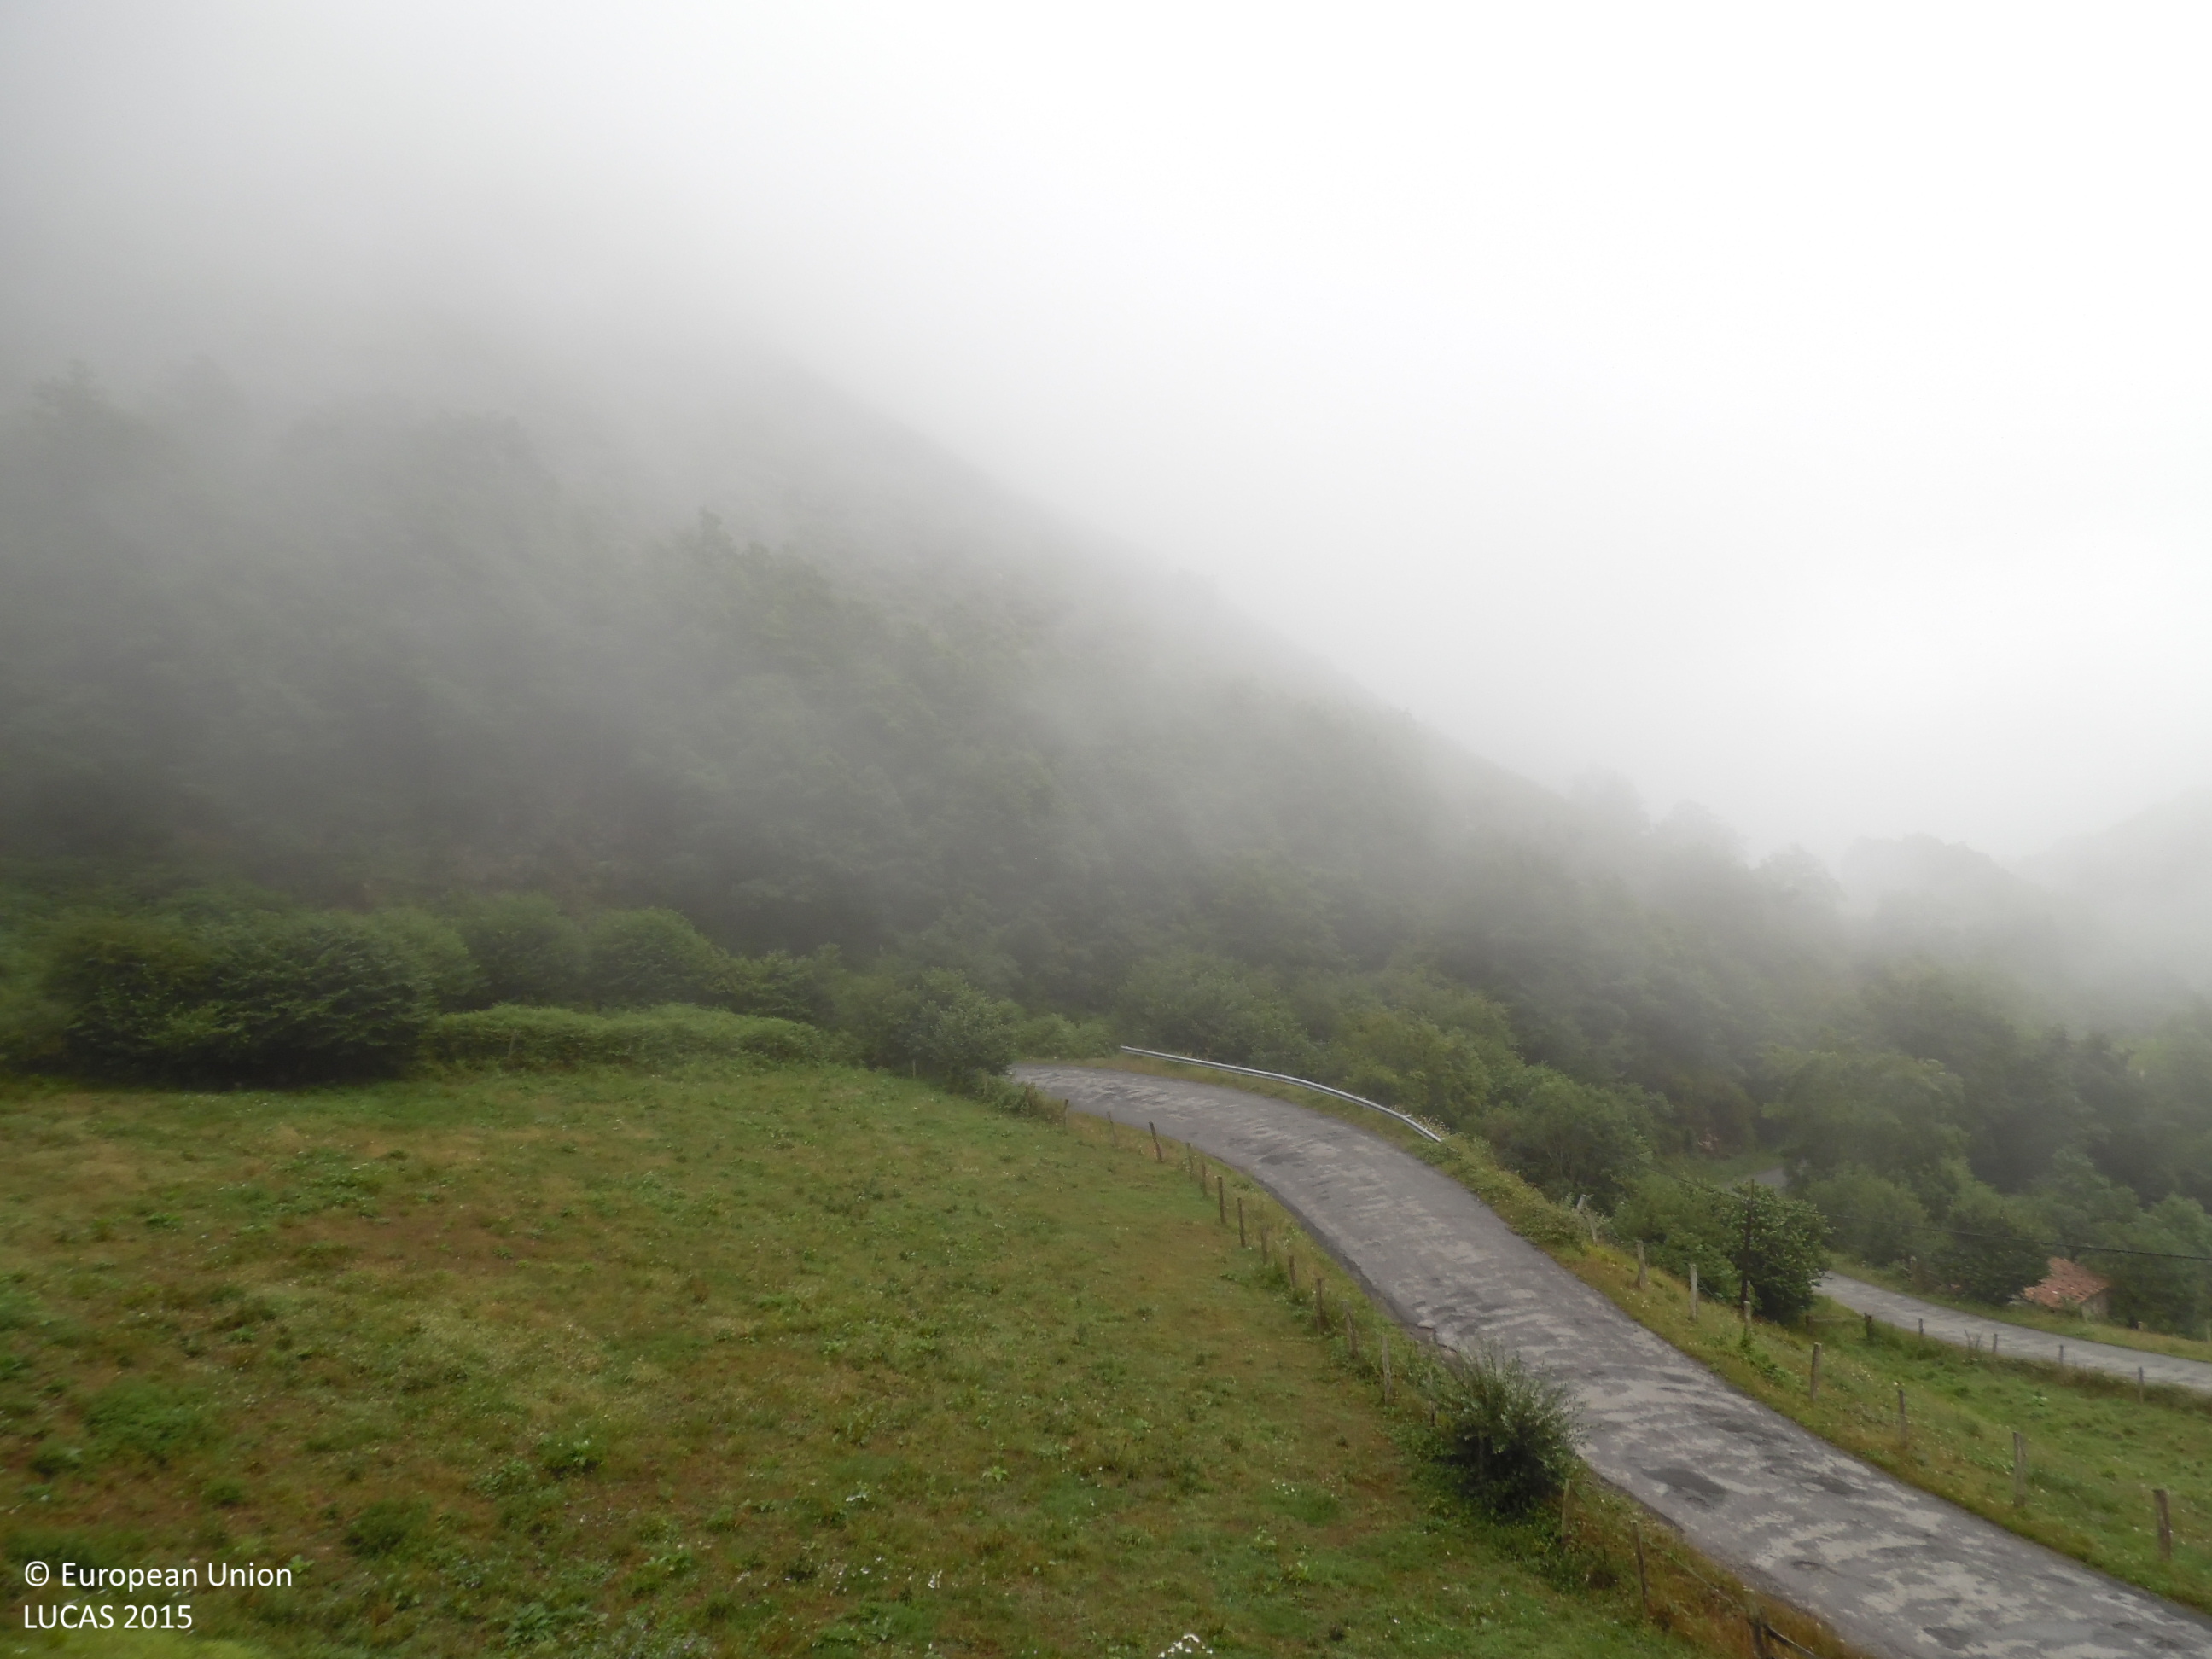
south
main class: Grassland
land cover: Grassland without tree/shrub cover
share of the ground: > 75 %
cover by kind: herbaceous plants 95 %, consolidated bare surface 5 %
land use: Agriculture (excluding fallow land and kitchen gardens)
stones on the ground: < 10 %
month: July
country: ES
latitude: 43.0229
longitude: -5.9027
